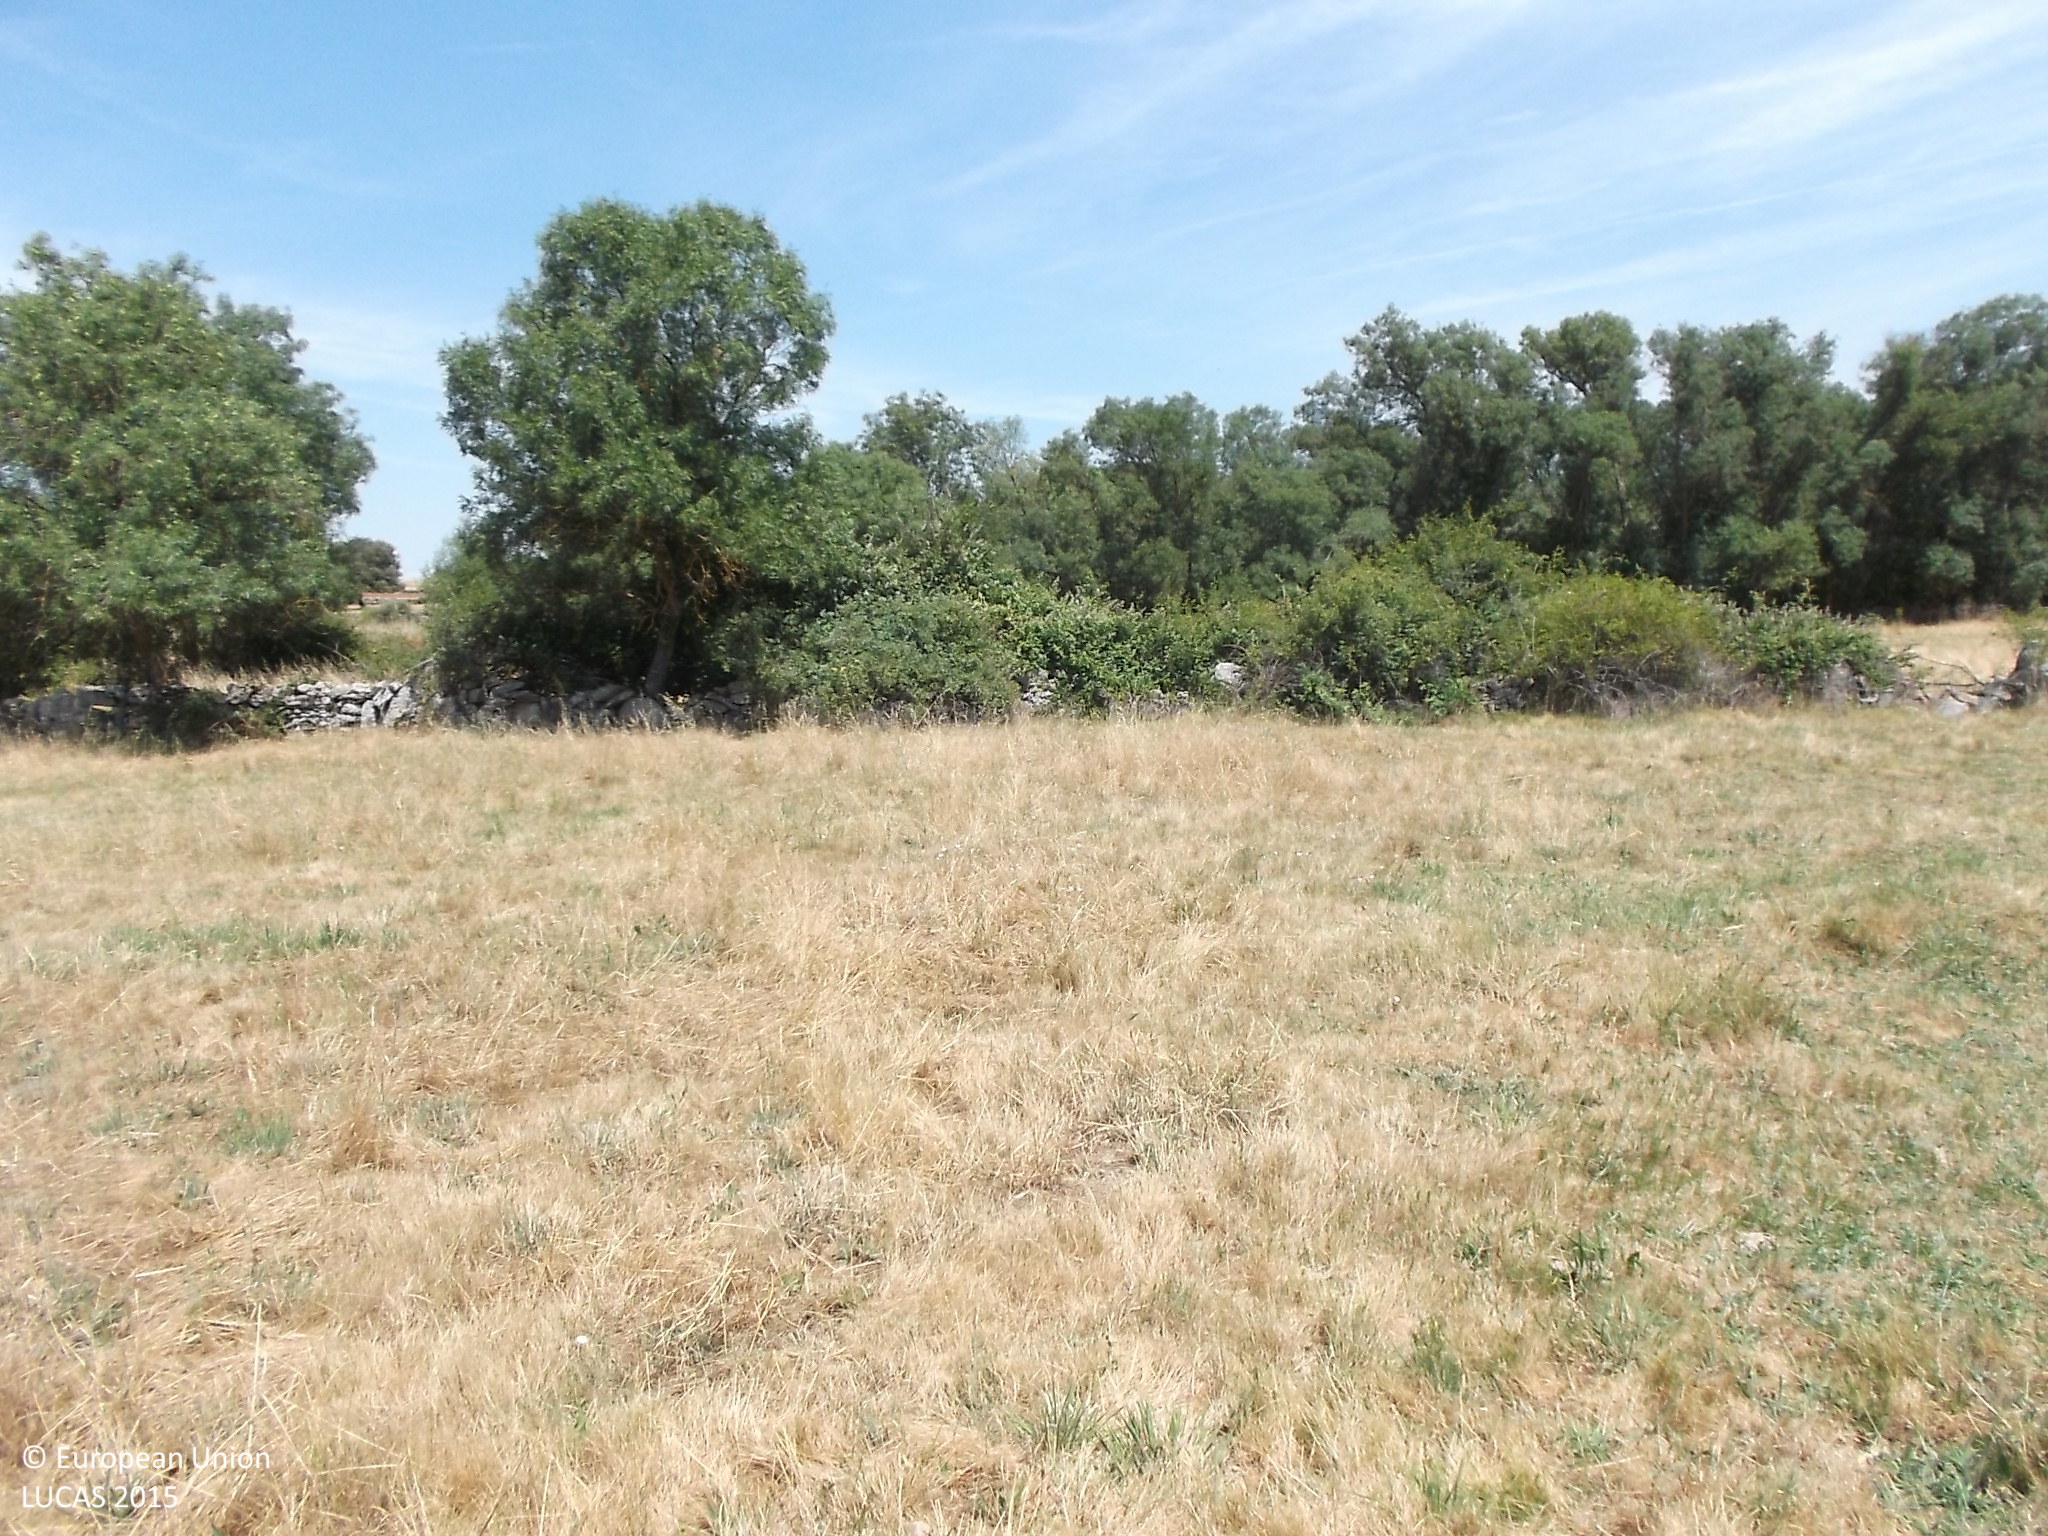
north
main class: Grassland
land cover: Grassland without tree/shrub cover
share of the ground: > 75 %
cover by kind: herbaceous plants 100 %
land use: Agriculture (excluding fallow land and kitchen gardens)
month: June
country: ES
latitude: 41.2624
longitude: -5.9989
